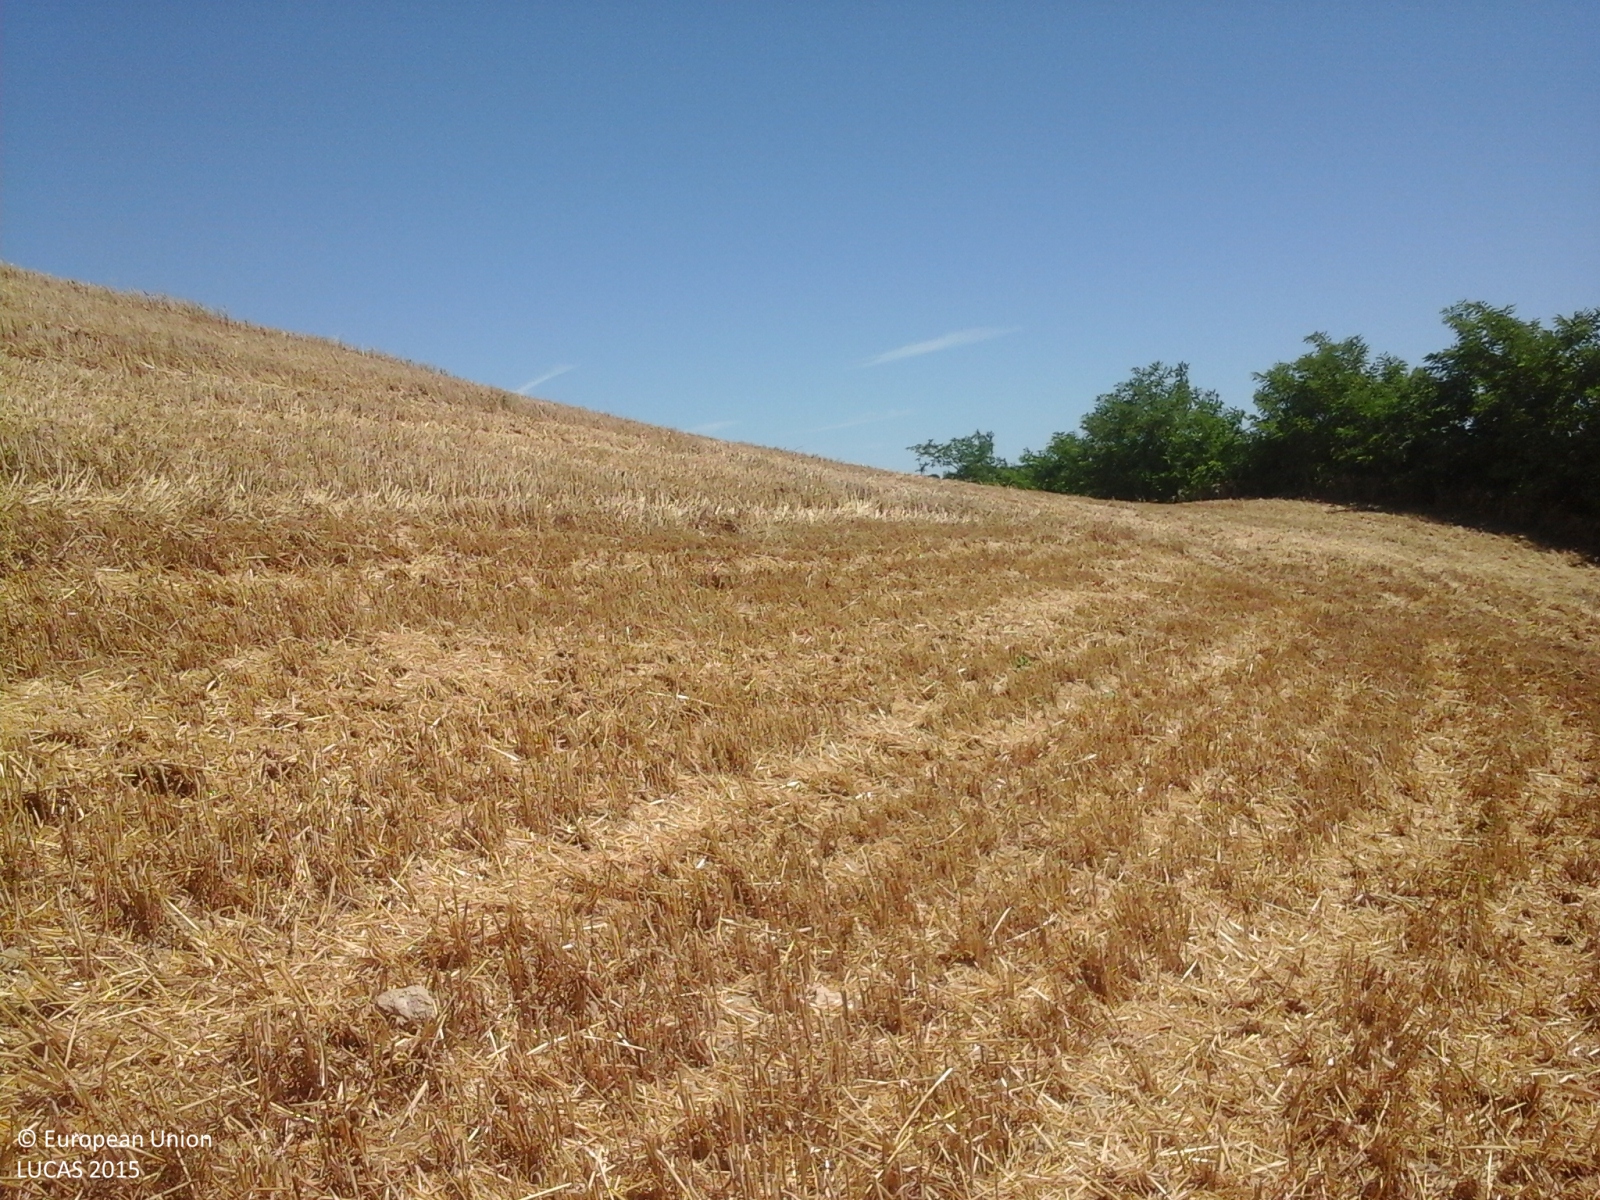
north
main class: Cropland
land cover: Durum wheat
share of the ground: > 75 %
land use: Agriculture (excluding fallow land and kitchen gardens)
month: June
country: IT
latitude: 43.5369
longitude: 10.6047
